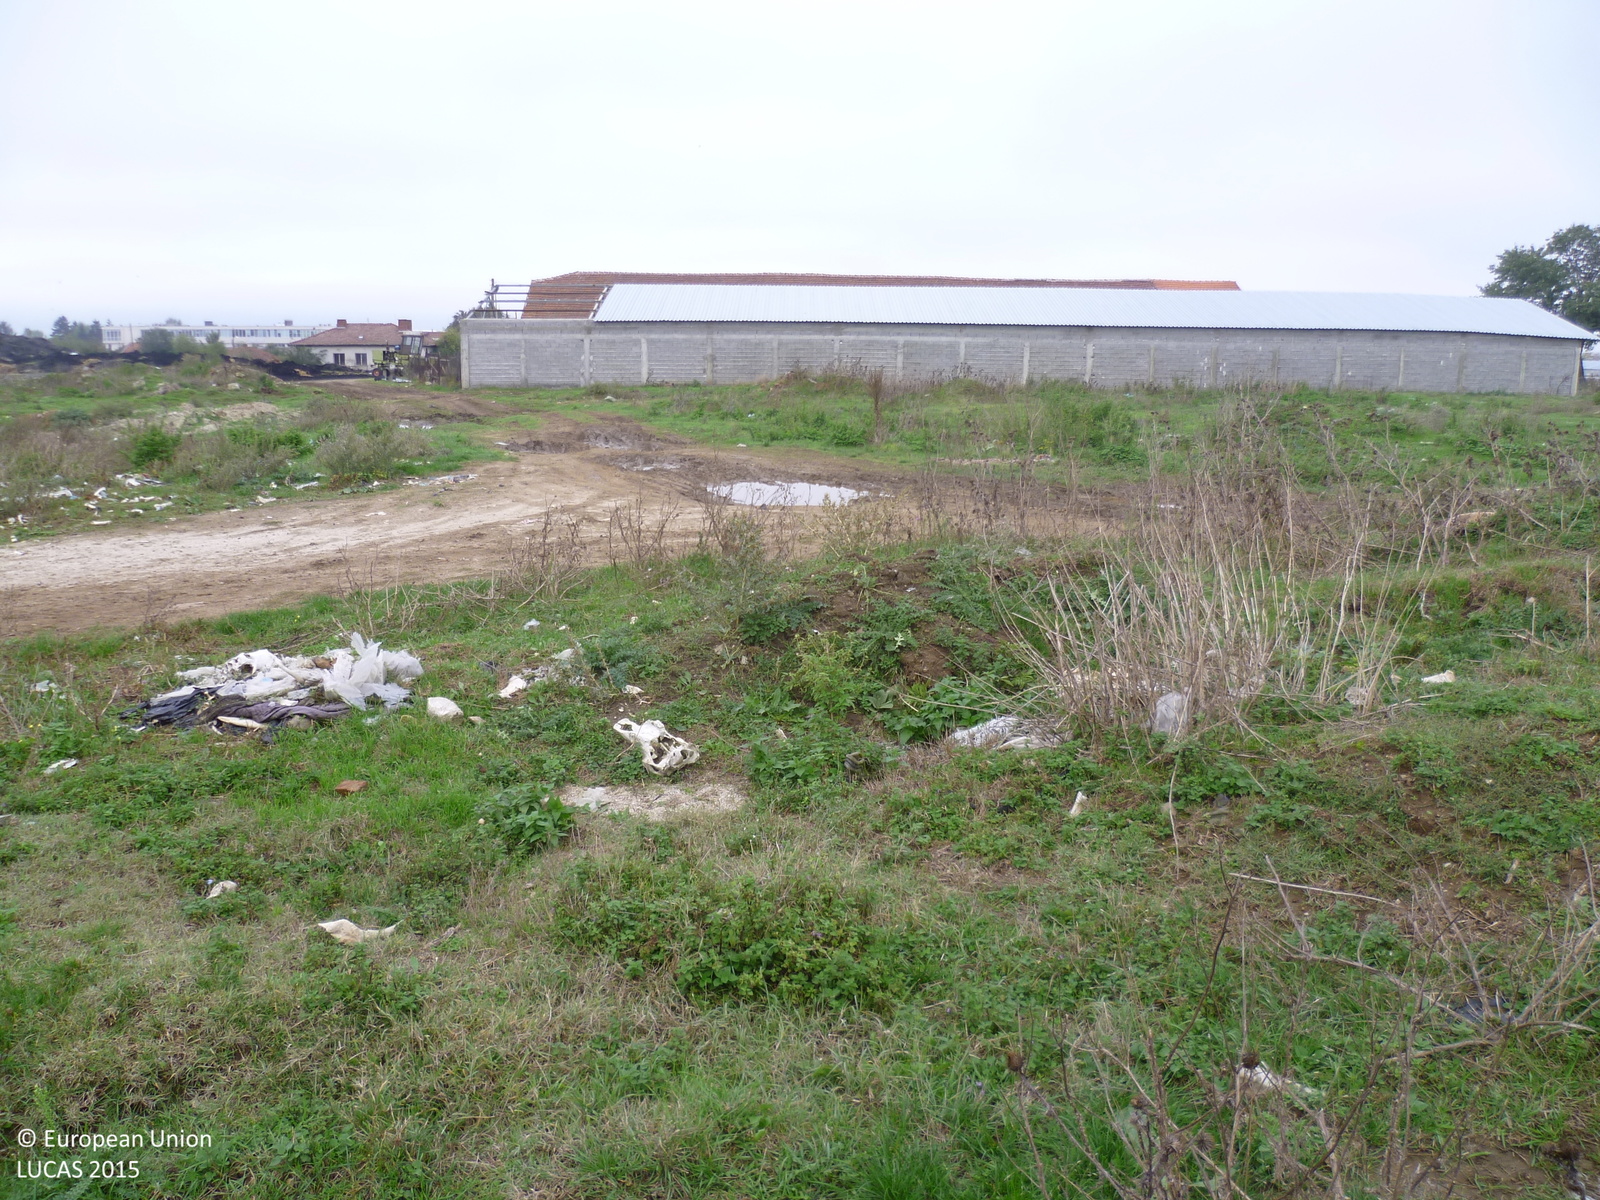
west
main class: Grassland
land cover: Grassland without tree/shrub cover
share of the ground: > 75 %
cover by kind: herbaceous plants 100 %
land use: Agriculture (excluding fallow land and kitchen gardens)
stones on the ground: < 10 %
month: October
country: BG
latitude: 42.4522
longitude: 23.8156
